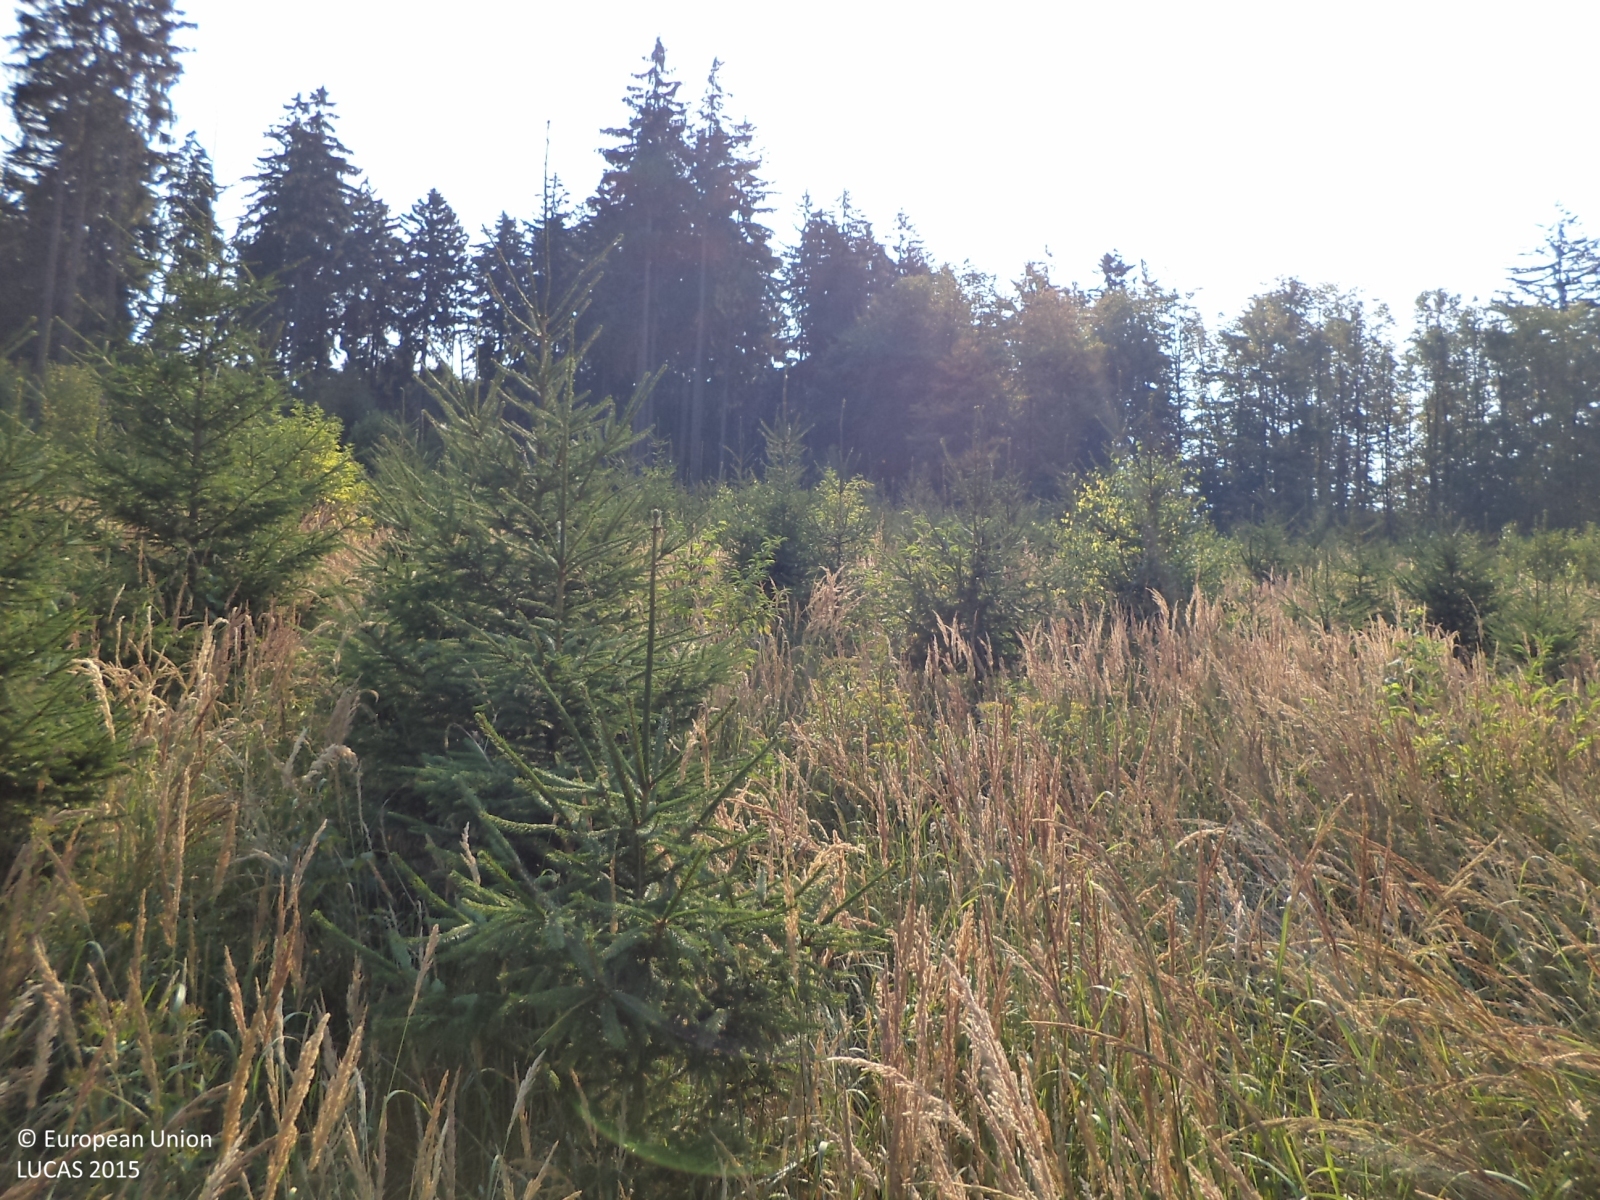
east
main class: Woodland
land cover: Spruce dominated coniferous woodland
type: hemiboreal forest and nemoral coniferous forest and mixed broadleaved-coniferous forest
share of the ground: > 75 %
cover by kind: coniferous forest trees 80 %, herbaceous plants 20 %
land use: Forestry
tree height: > 5 m
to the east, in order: Spruce dominated coniferous woodland; Broadleaved woodland; Tracks; Spruce dominated coniferous woodland; Other bare soil
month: August
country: CZ
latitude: 49.5205
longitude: 14.4633
